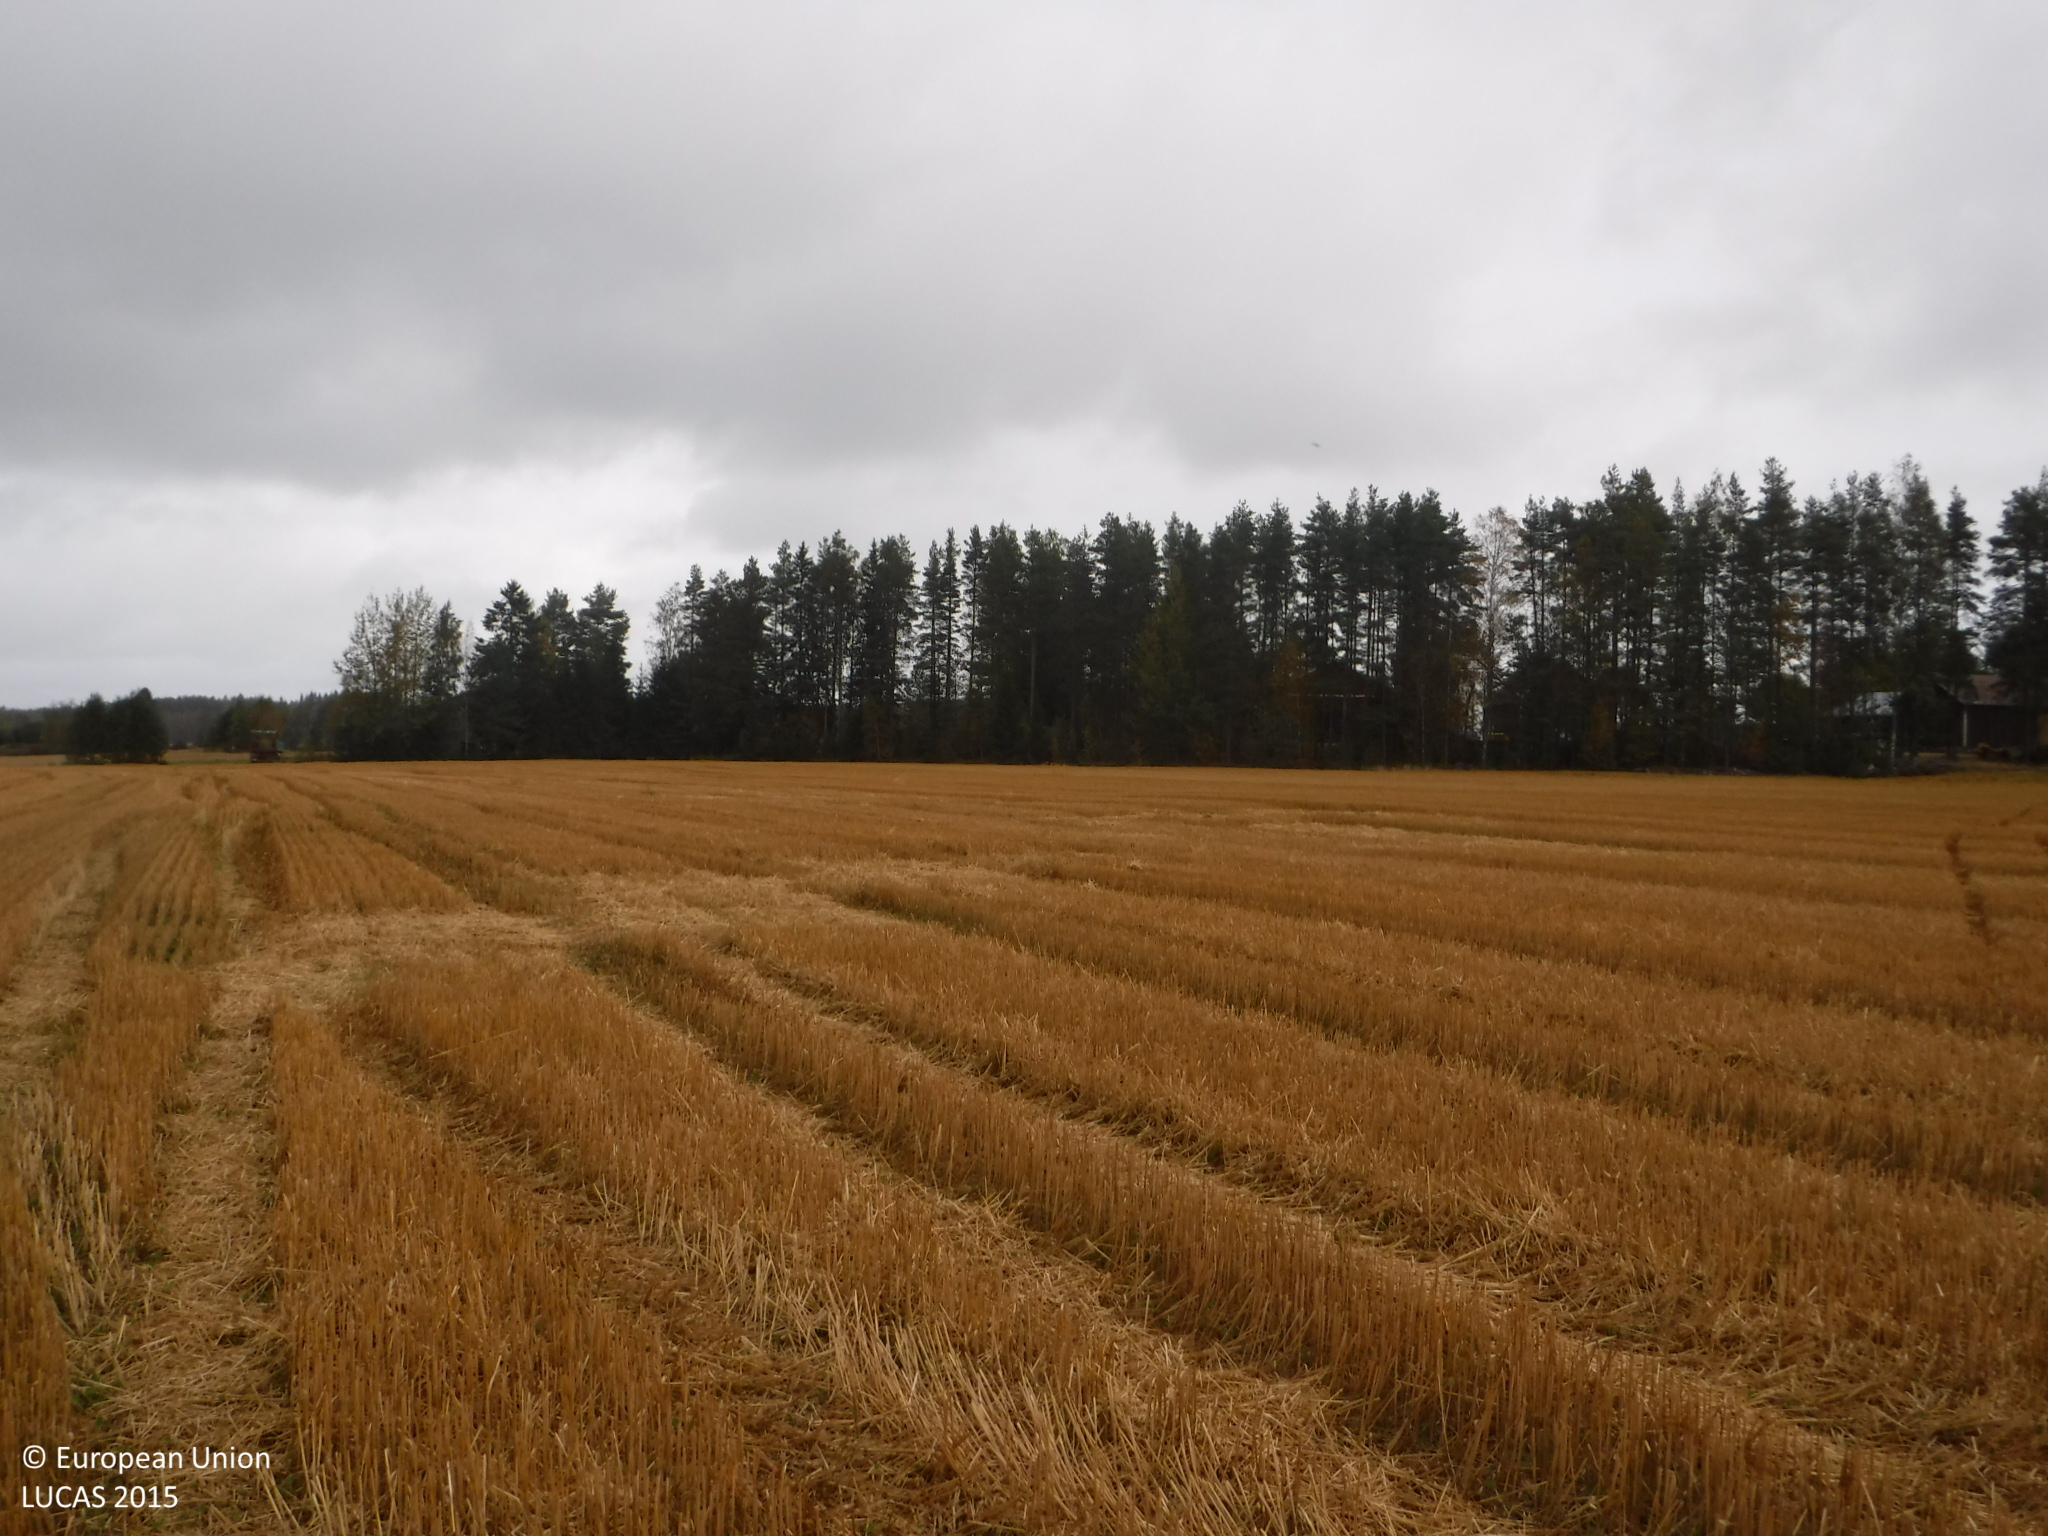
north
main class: Cropland
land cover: Oats
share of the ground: > 75 %
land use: Agriculture (excluding fallow land and kitchen gardens)
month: September
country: FI
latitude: 61.9852
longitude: 22.2127
